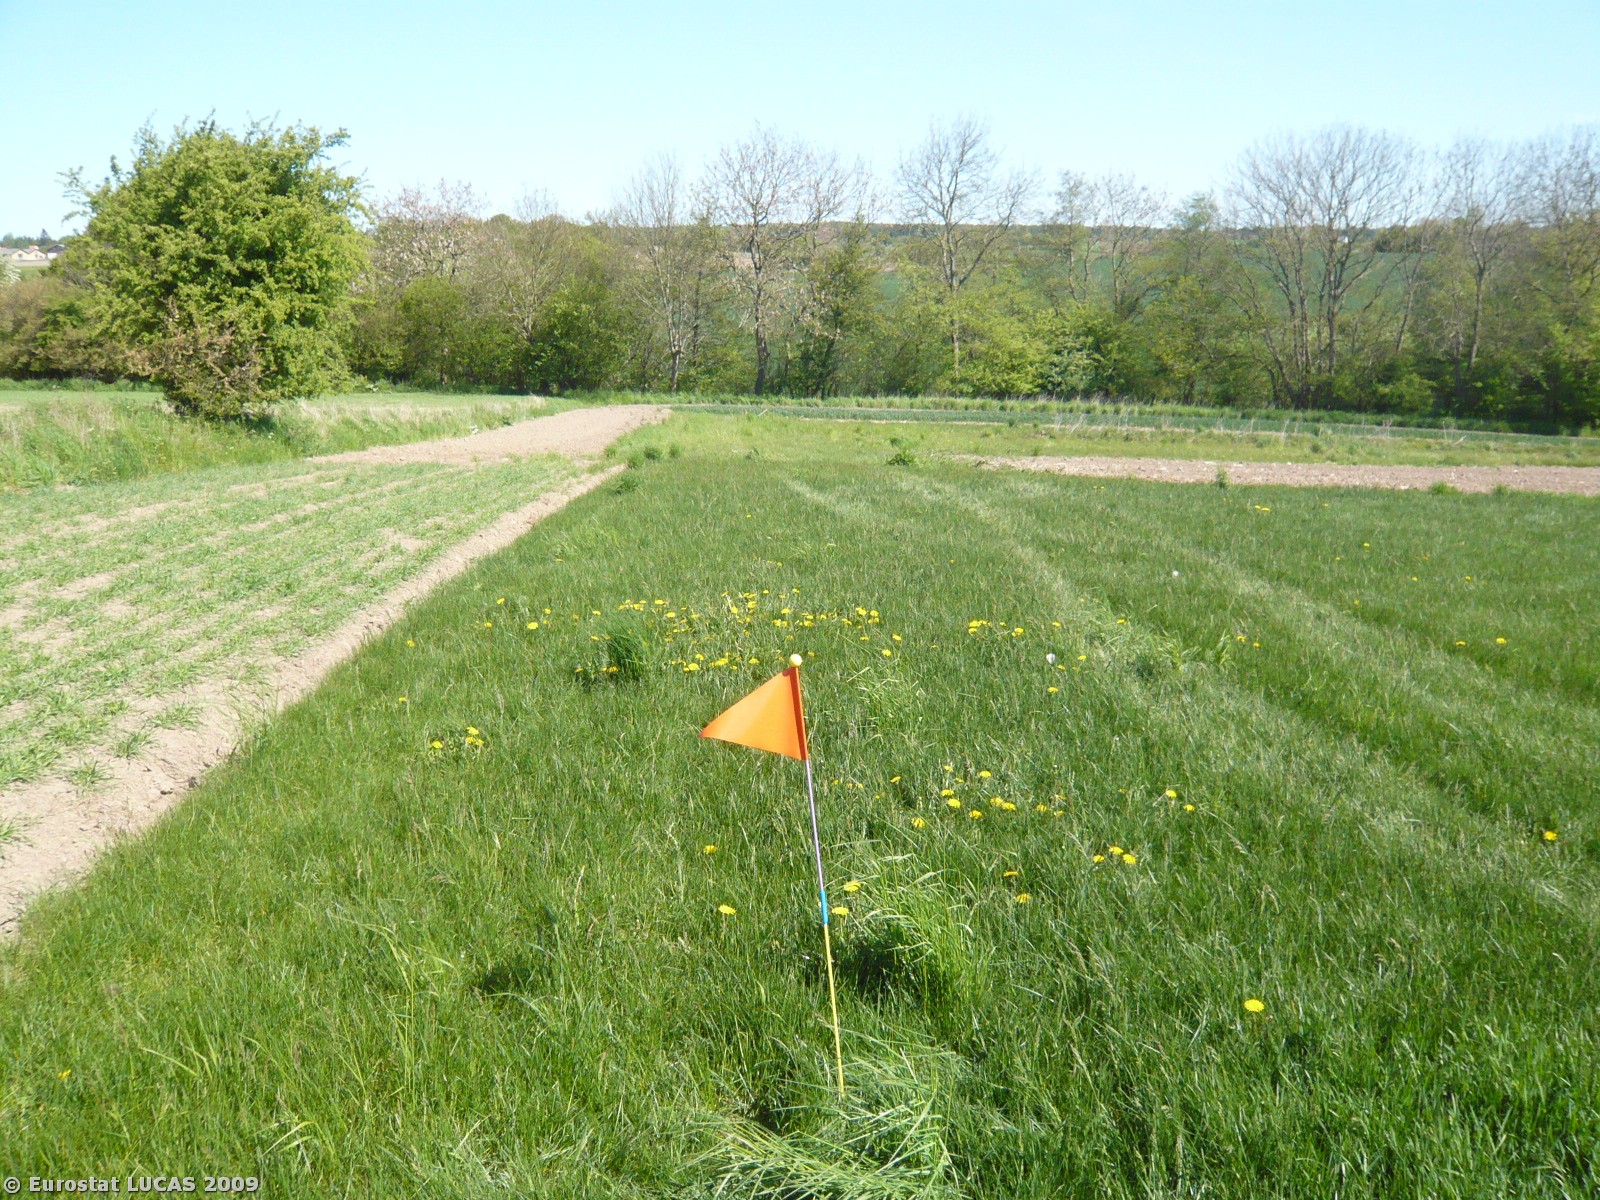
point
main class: Grassland
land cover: Grassland without tree/shrub cover
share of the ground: > 75 %
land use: Agriculture (excluding fallow land and kitchen gardens)
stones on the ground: < 10 %
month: May
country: DK
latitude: 55.1654
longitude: 11.9922
